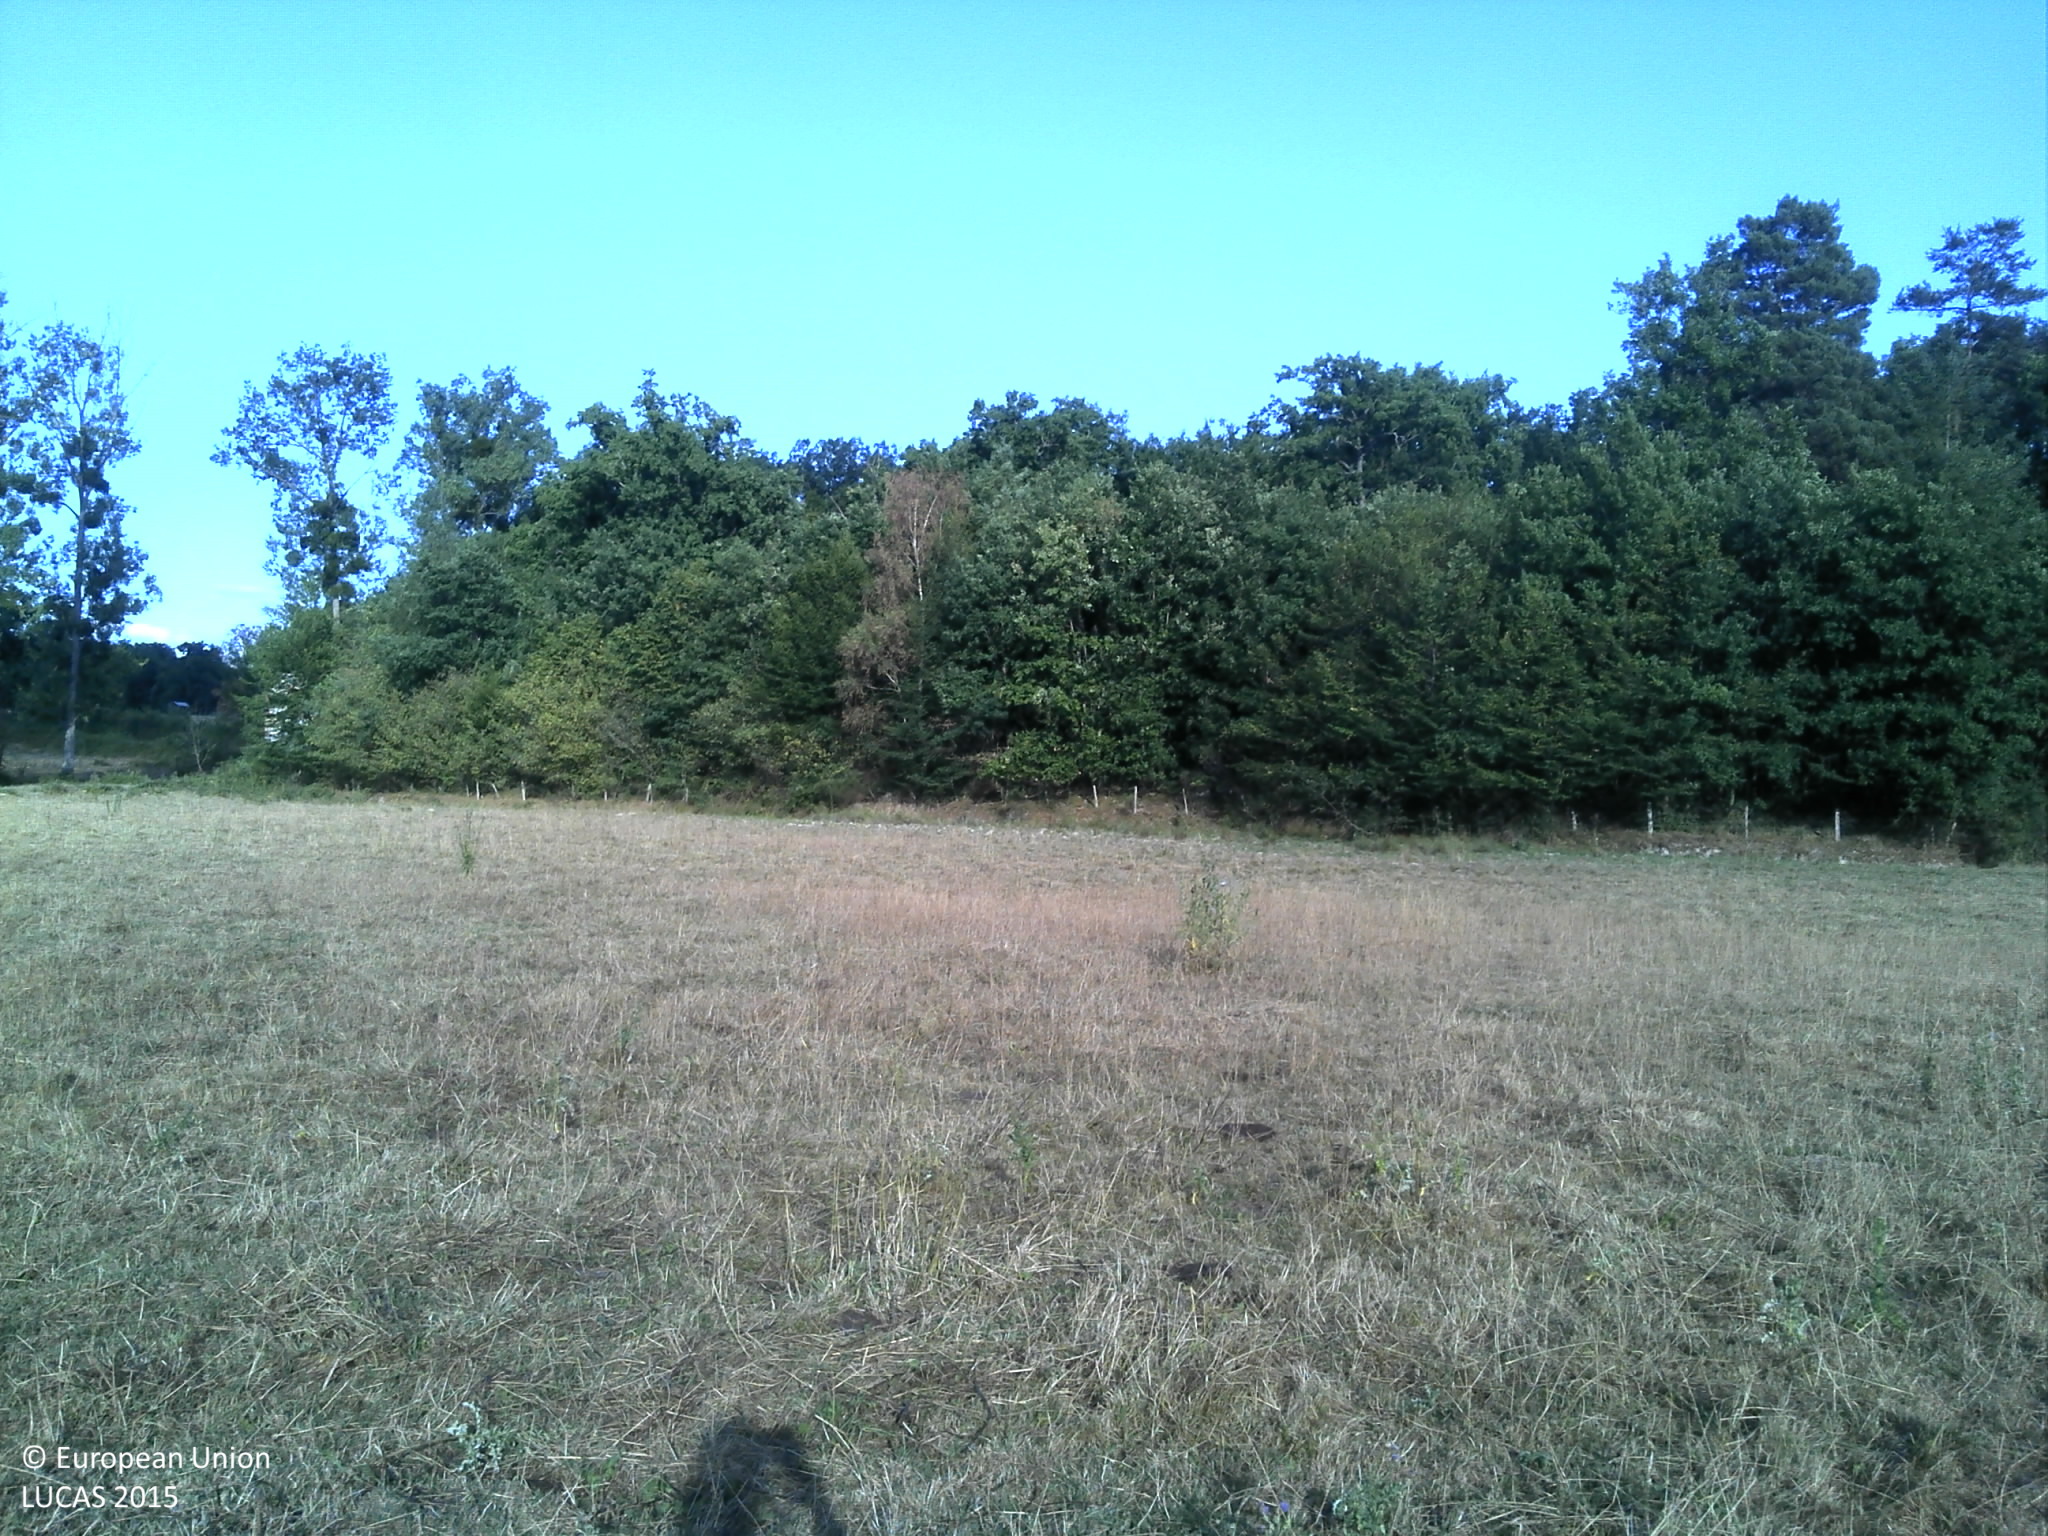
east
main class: Grassland
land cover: Grassland without tree/shrub cover
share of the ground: > 75 %
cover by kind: herbaceous plants 100 %
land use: Agriculture (excluding fallow land and kitchen gardens)
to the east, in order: Grassland without tree/shrub cover; Ditches and canals; Fences; Broadleaved woodland; Ditches and canals; Broadleaved woodland; Grass margins; Tracks; Grass margins; Broadleaved woodland; Grass margins; Abandoned hedges; Dry stone walls; Grassland without tree/shrub cover
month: July
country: FR
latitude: 45.8282
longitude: 4.1195
